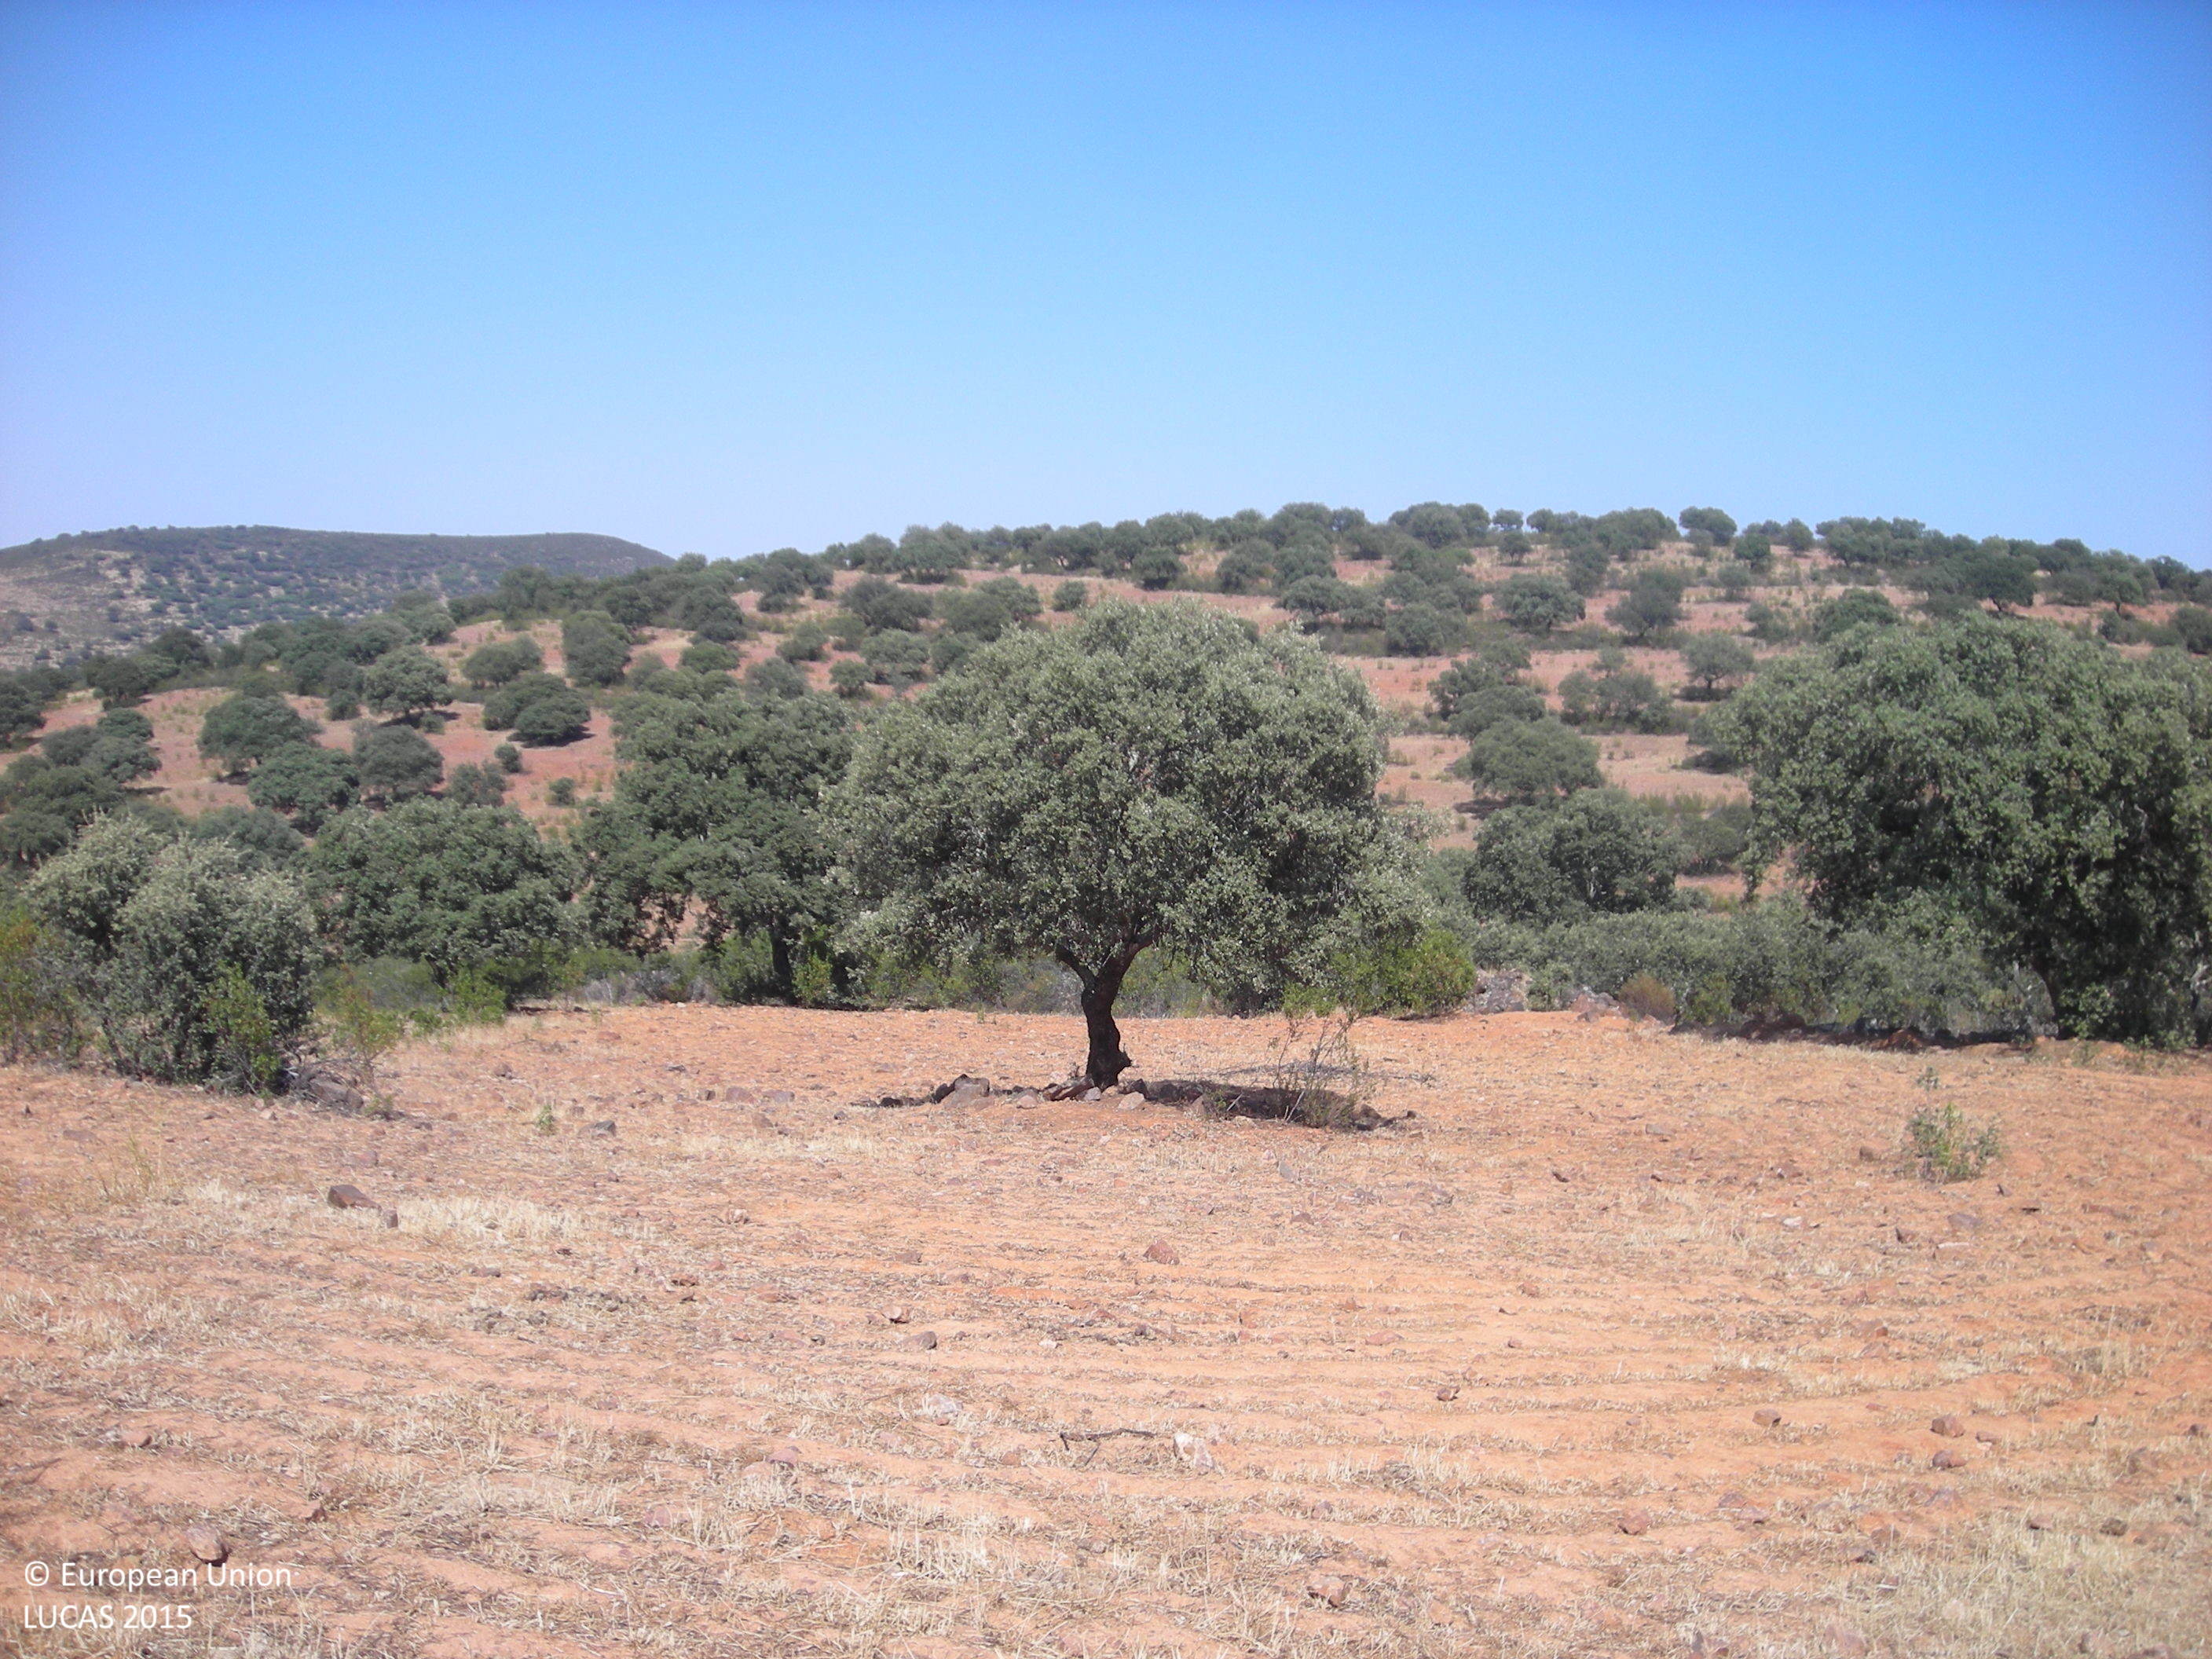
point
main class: Woodland
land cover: Broadleaved woodland
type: broadleaved evergreen forest
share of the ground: 10 - 25 %
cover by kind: unconsolidated bare surface 65 %, herbaceous plants 20 %, broadleaved forest trees 15 %
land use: Forestry
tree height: > 5 m
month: June
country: ES
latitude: 38.6046
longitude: -5.8320
